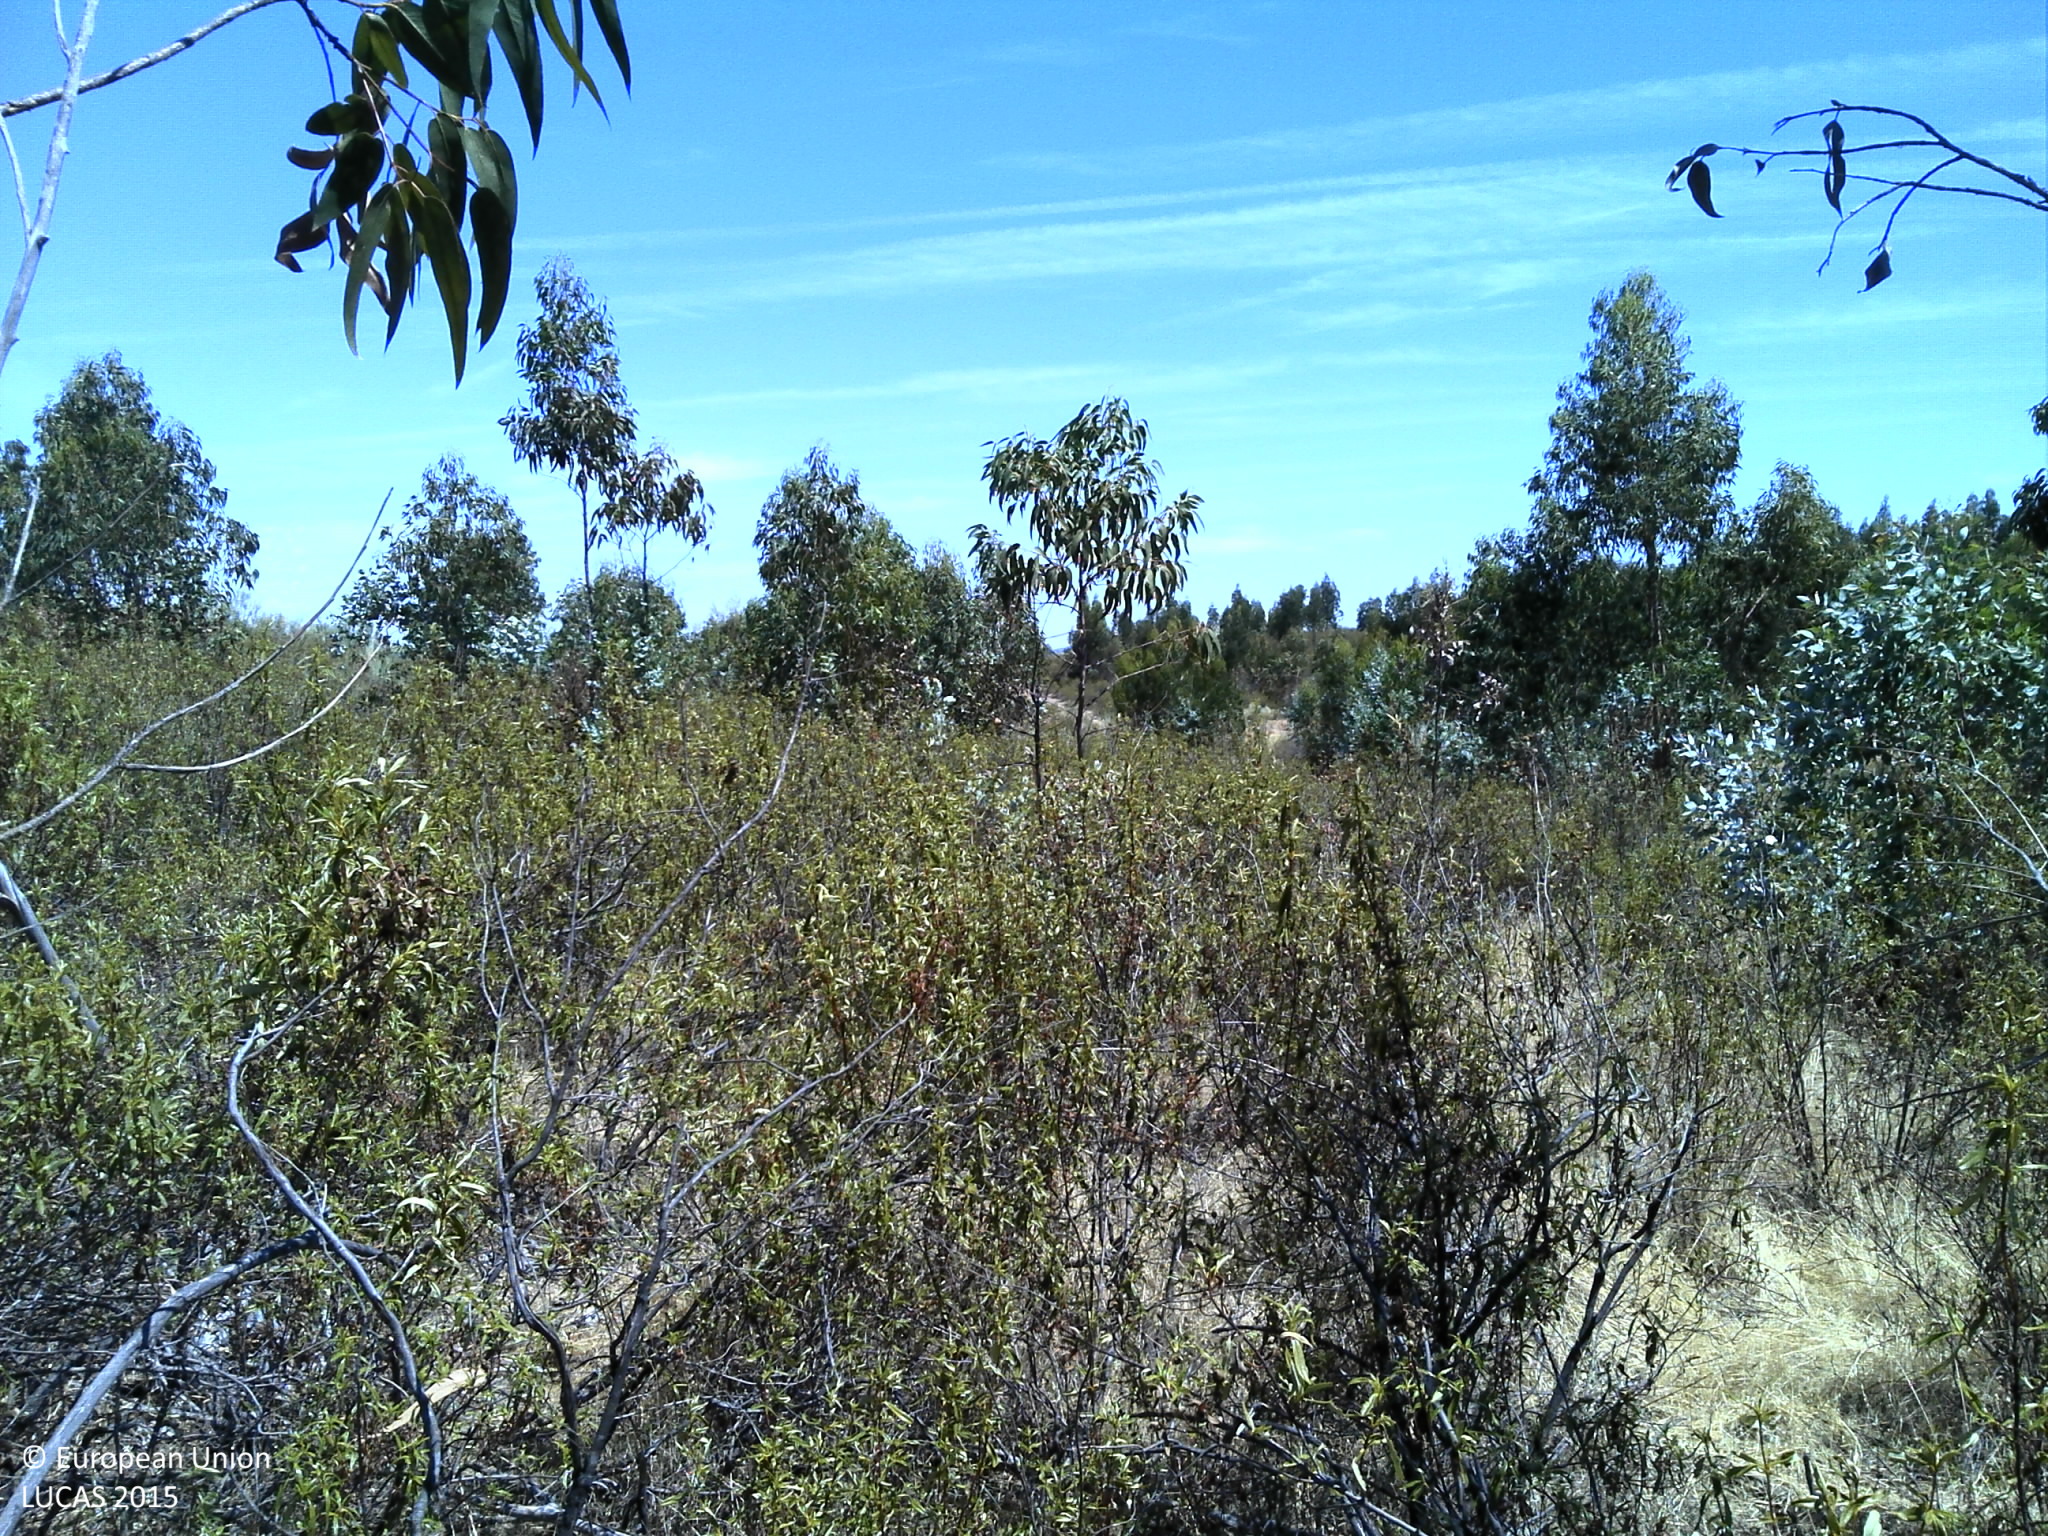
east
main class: Woodland
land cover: Broadleaved woodland
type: exotic forest
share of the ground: 10 - 25 %
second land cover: Shrubland without tree cover
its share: > 75 %
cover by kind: shrubs 90 %, broadleaved forest trees 10 %
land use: Forestry
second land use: Agriculture (excluding fallow land and kitchen gardens)
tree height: > 5 m
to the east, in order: Broadleaved woodland; Shrubland without tree cover; Broadleaved woodland; Shrubland without tree cover; Inland fresh water bodies; Shrubland without tree cover
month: August
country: PT
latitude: 39.5364
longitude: -7.4642
